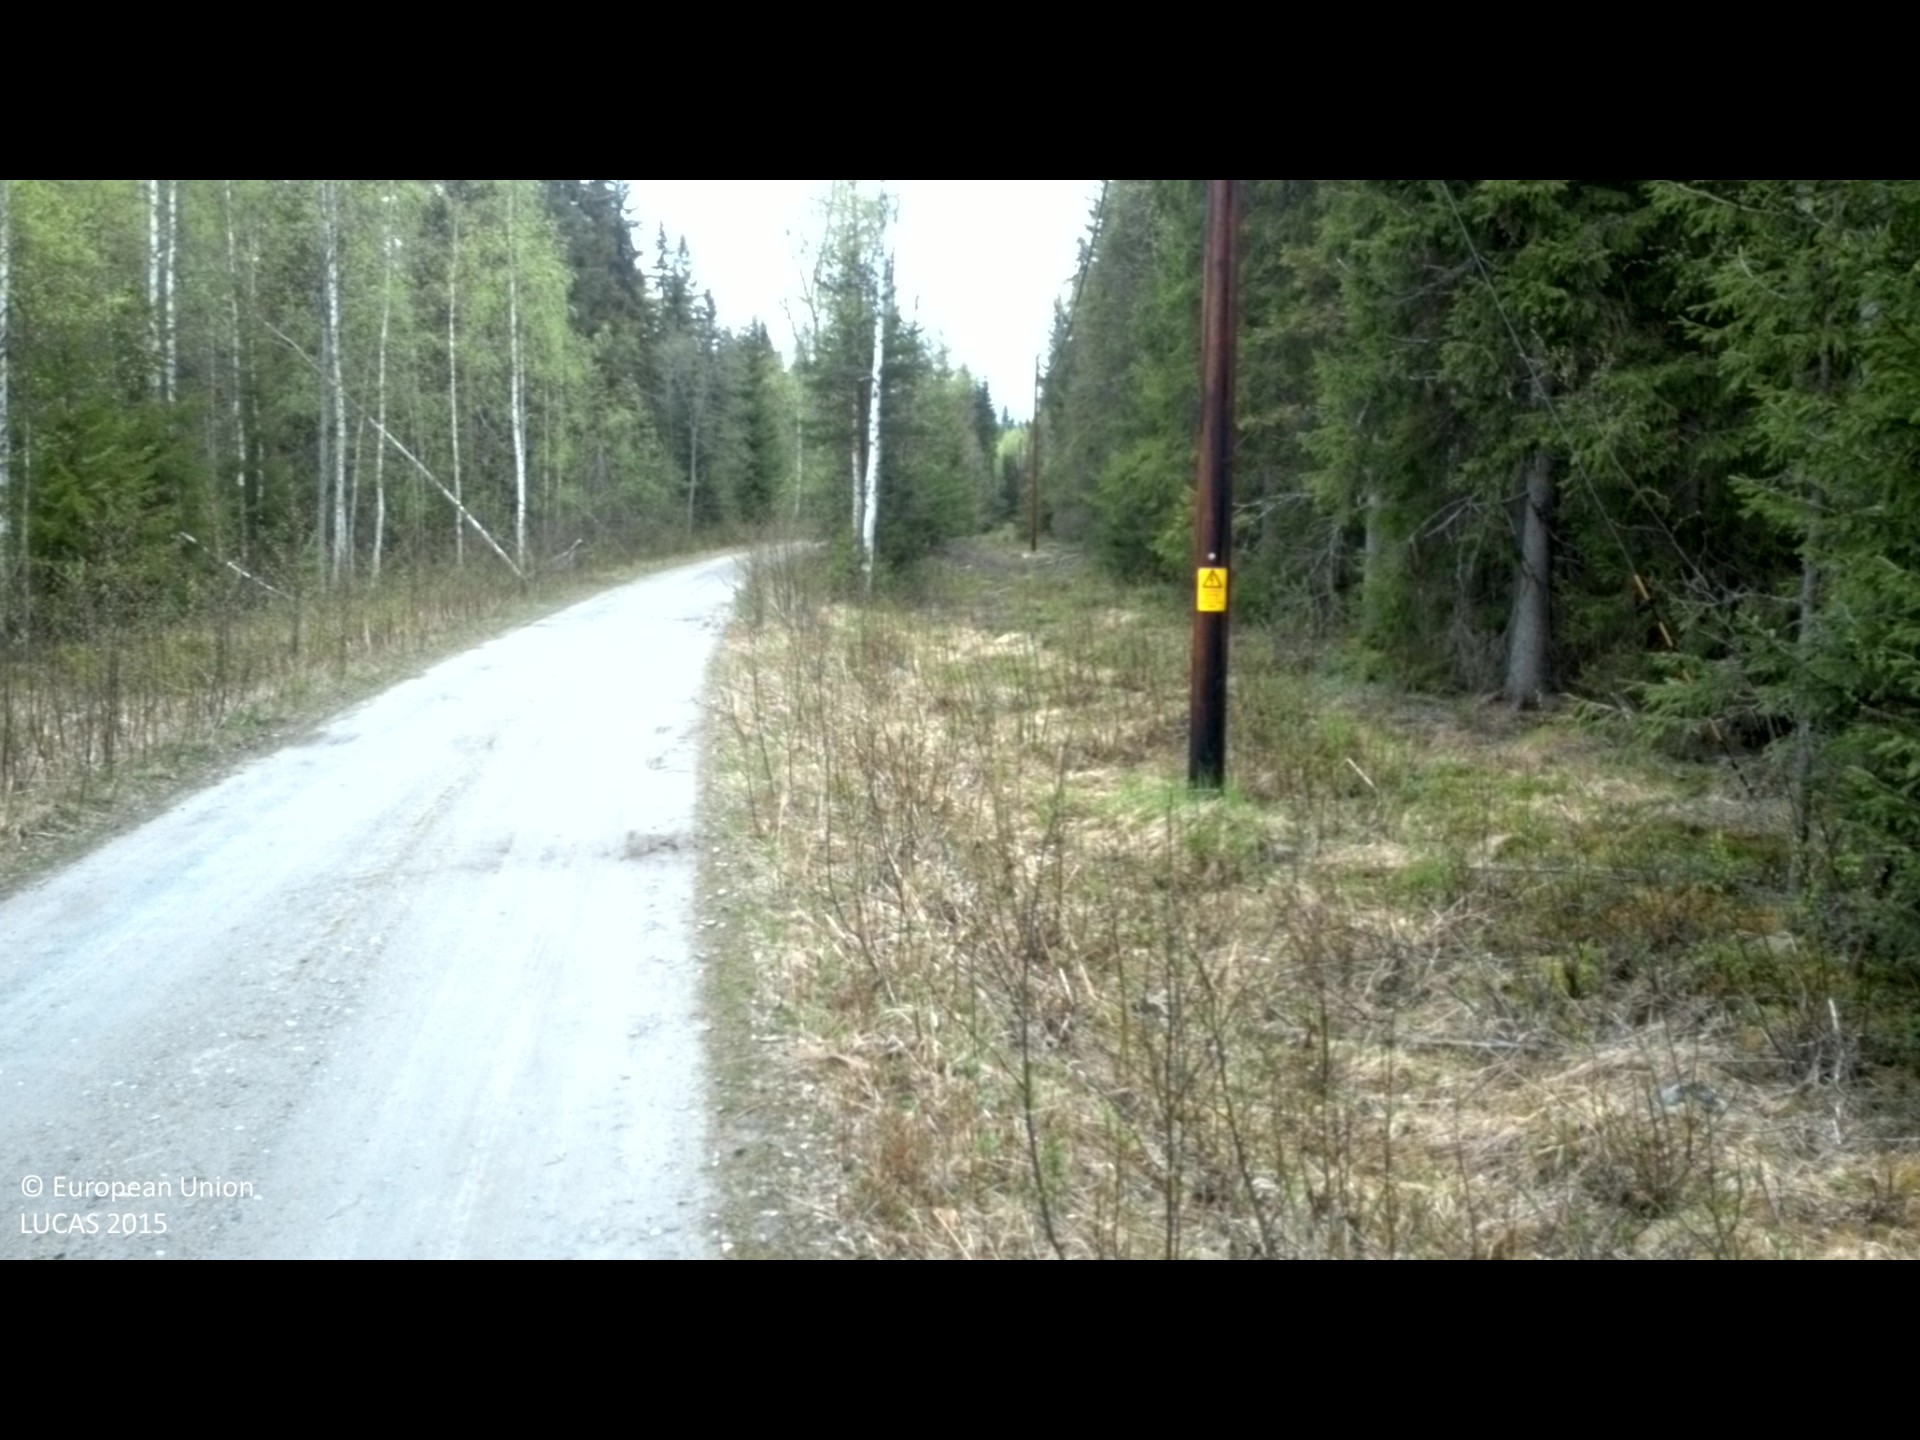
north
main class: Woodland
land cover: Spruce dominated coniferous woodland
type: boreal forest
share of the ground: > 75 %
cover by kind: coniferous forest trees 90 %, shrubs 10 %
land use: Forestry
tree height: > 5 m
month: May
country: SE
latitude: 63.0846
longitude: 17.3622
